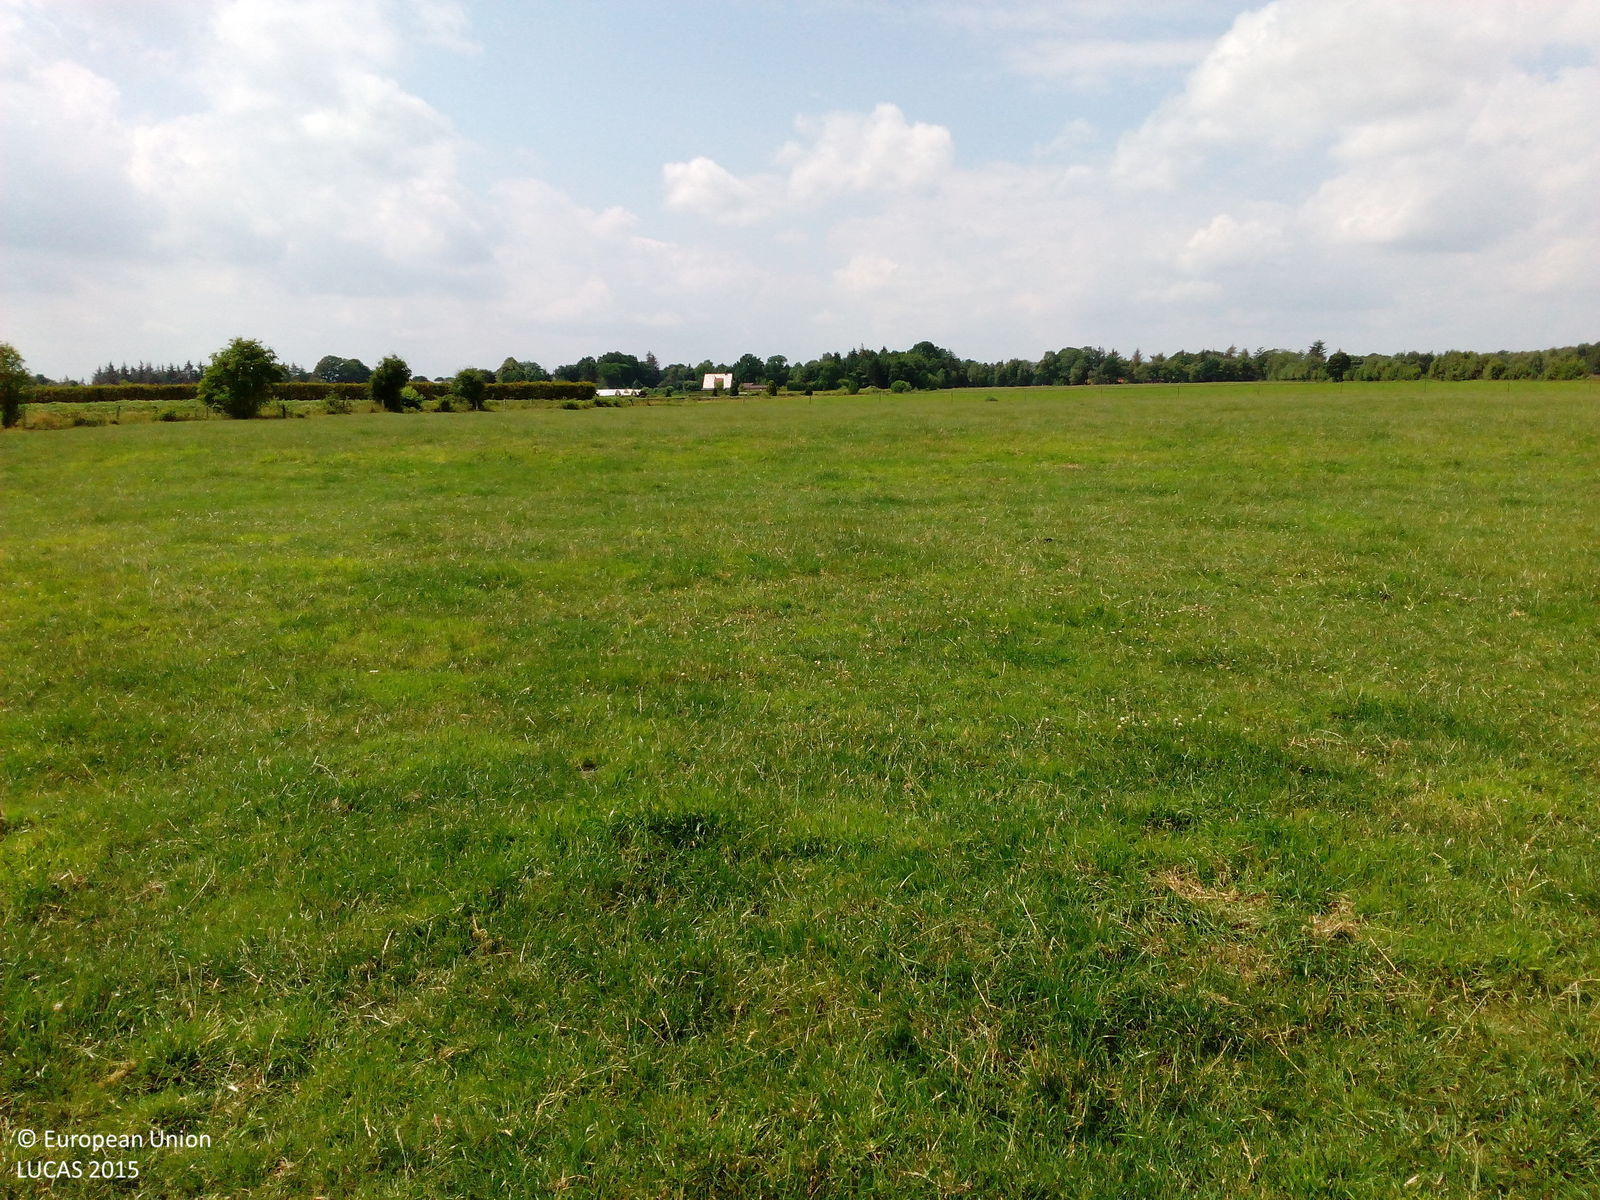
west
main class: Grassland
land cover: Grassland without tree/shrub cover
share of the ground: > 75 %
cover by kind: herbaceous plants 100 %
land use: Agriculture (excluding fallow land and kitchen gardens)
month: July
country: DE
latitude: 53.3115
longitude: 7.8844
